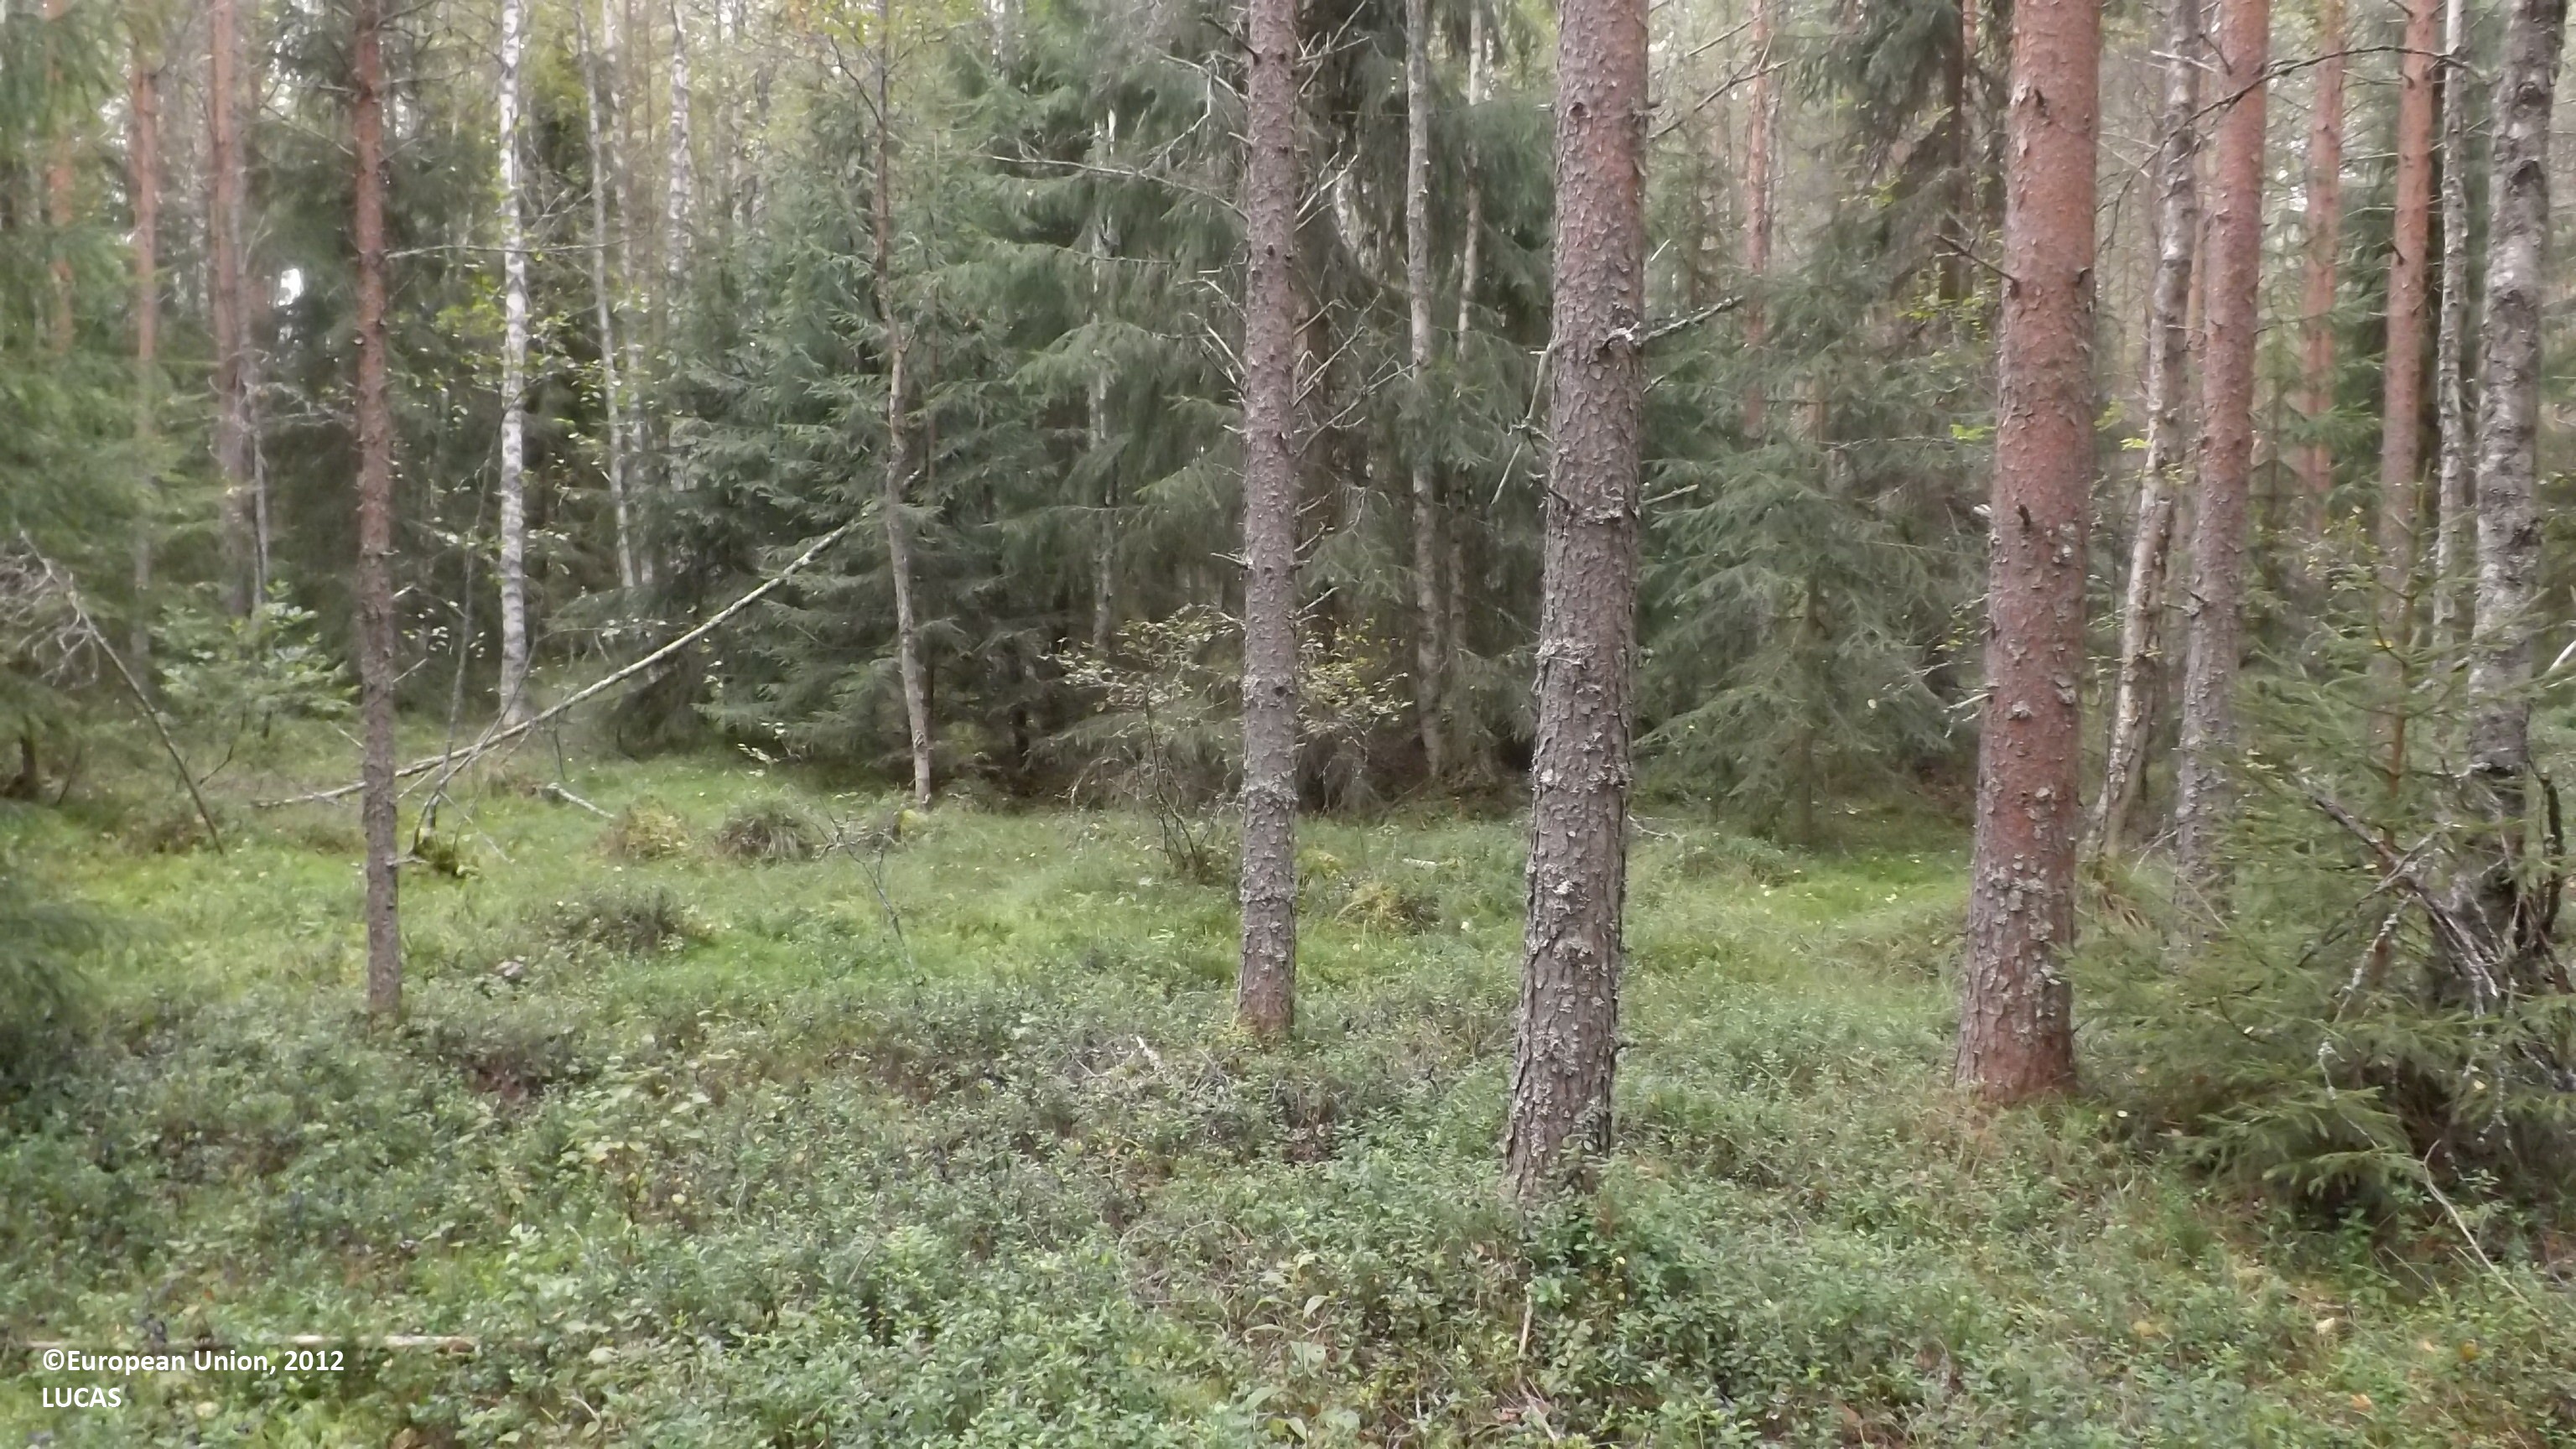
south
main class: Woodland
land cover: Pine dominated mixed woodland
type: boreal forest
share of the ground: 50 - 75 %
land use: Forestry
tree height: > 5 m
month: August
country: FI
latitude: 63.8967
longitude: 24.0623
